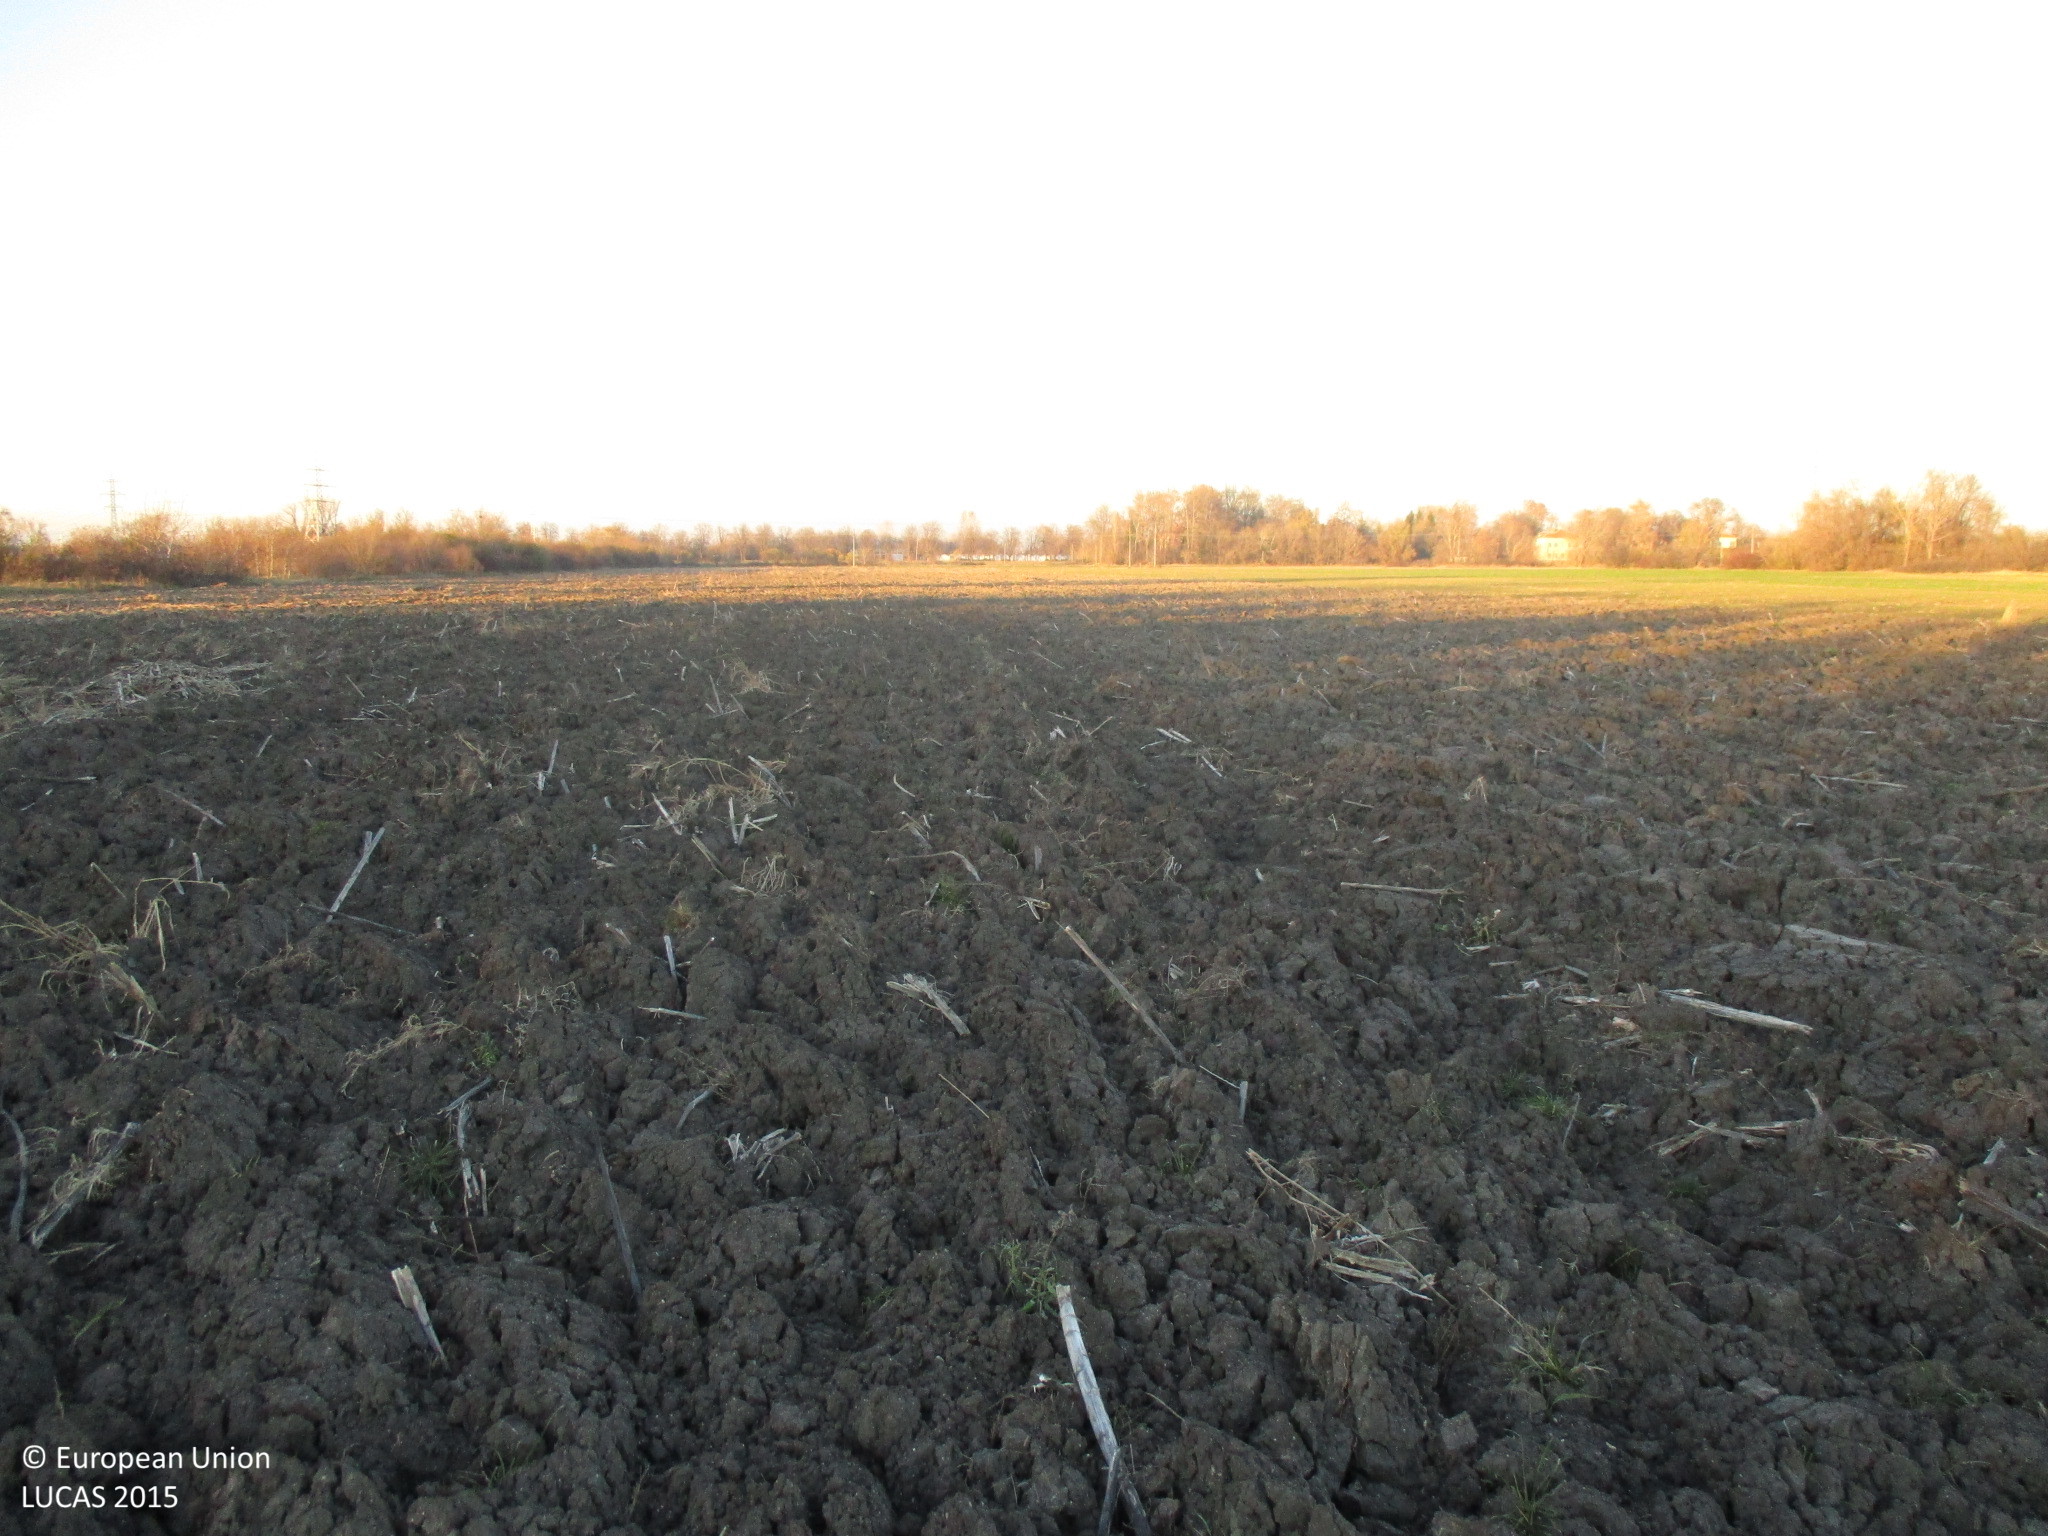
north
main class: Cropland
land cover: Sunflower
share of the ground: < 10 %
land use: Agriculture (excluding fallow land and kitchen gardens)
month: December
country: BG
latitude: 42.1707
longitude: 24.7598
